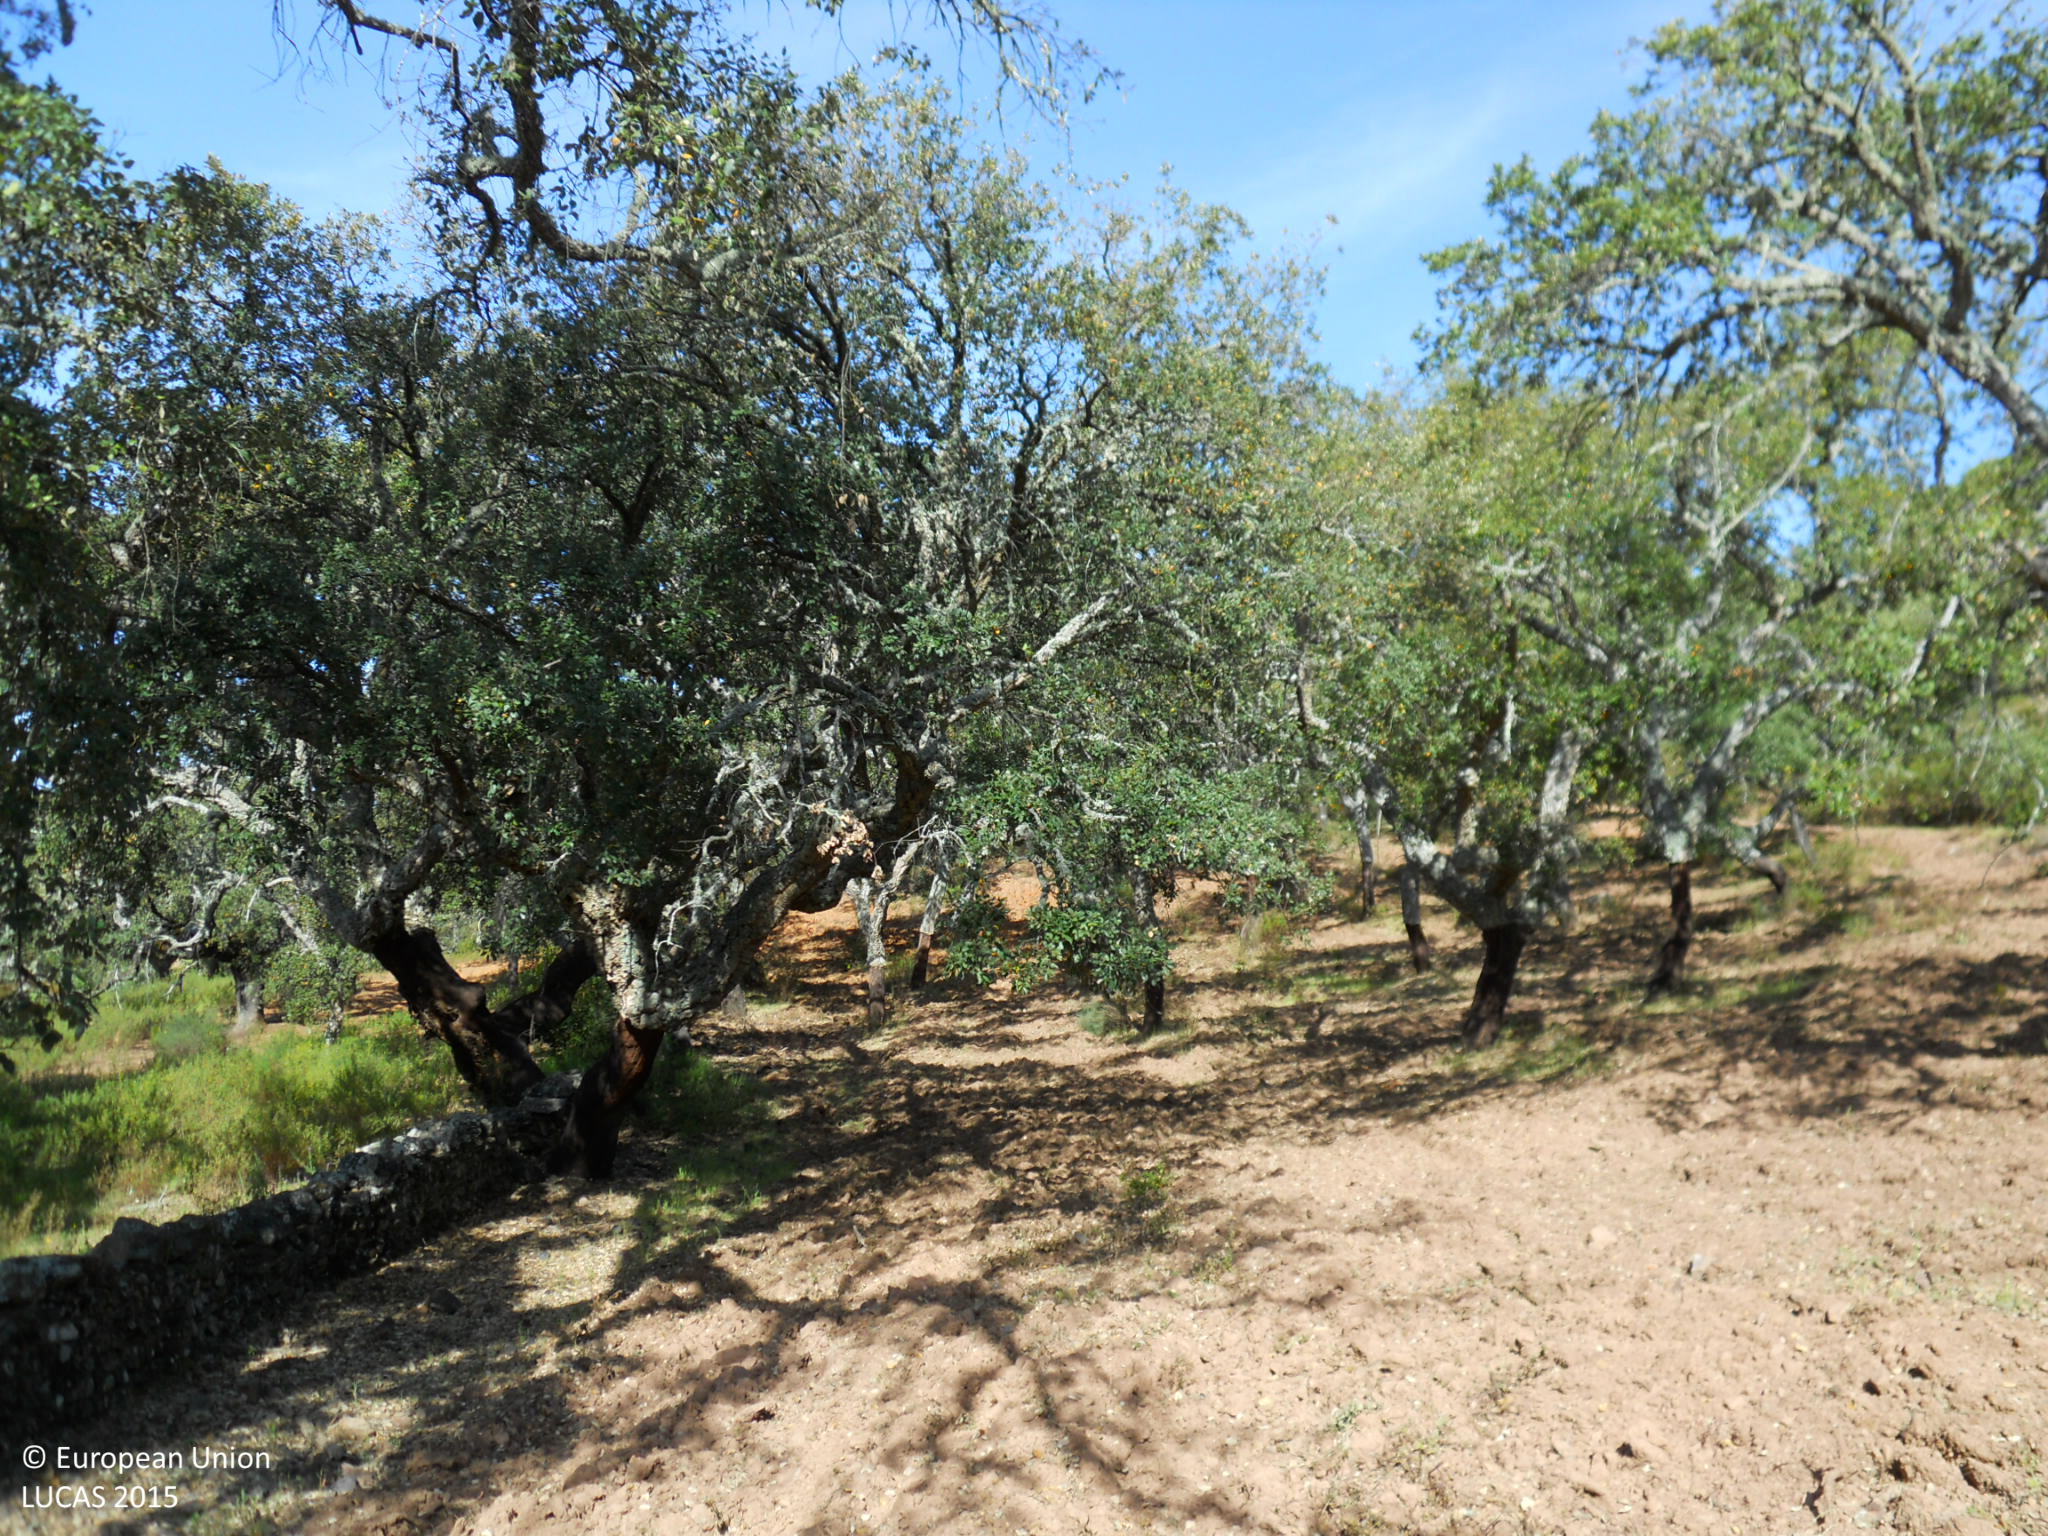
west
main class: Woodland
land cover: Broadleaved woodland
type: broadleaved evergreen forest
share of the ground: > 75 %
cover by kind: broadleaved forest trees 90 %, unconsolidated bare surface 10 %
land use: Forestry
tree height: > 5 m
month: April
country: ES
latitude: 39.2049
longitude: -6.9476
